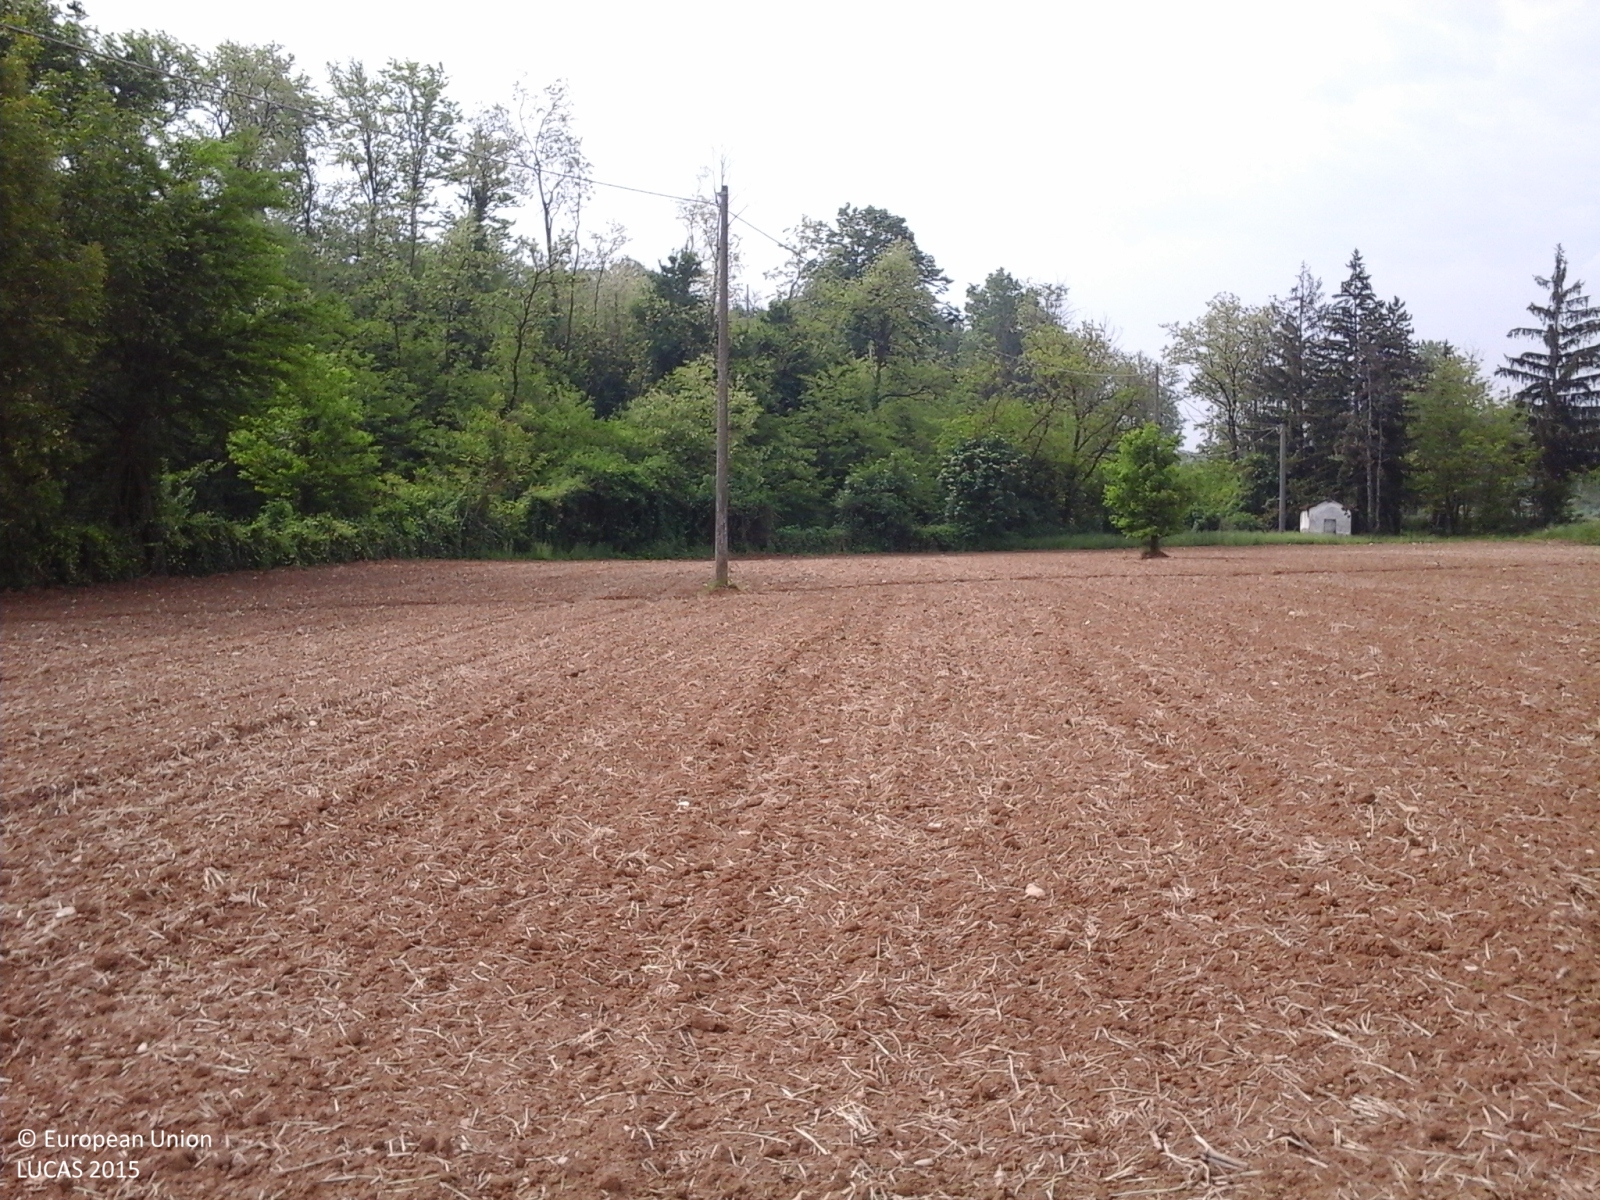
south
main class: Cropland
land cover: Maize
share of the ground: < 10 %
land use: Agriculture (excluding fallow land and kitchen gardens)
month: May
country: IT
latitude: 44.9089
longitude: 9.6334
